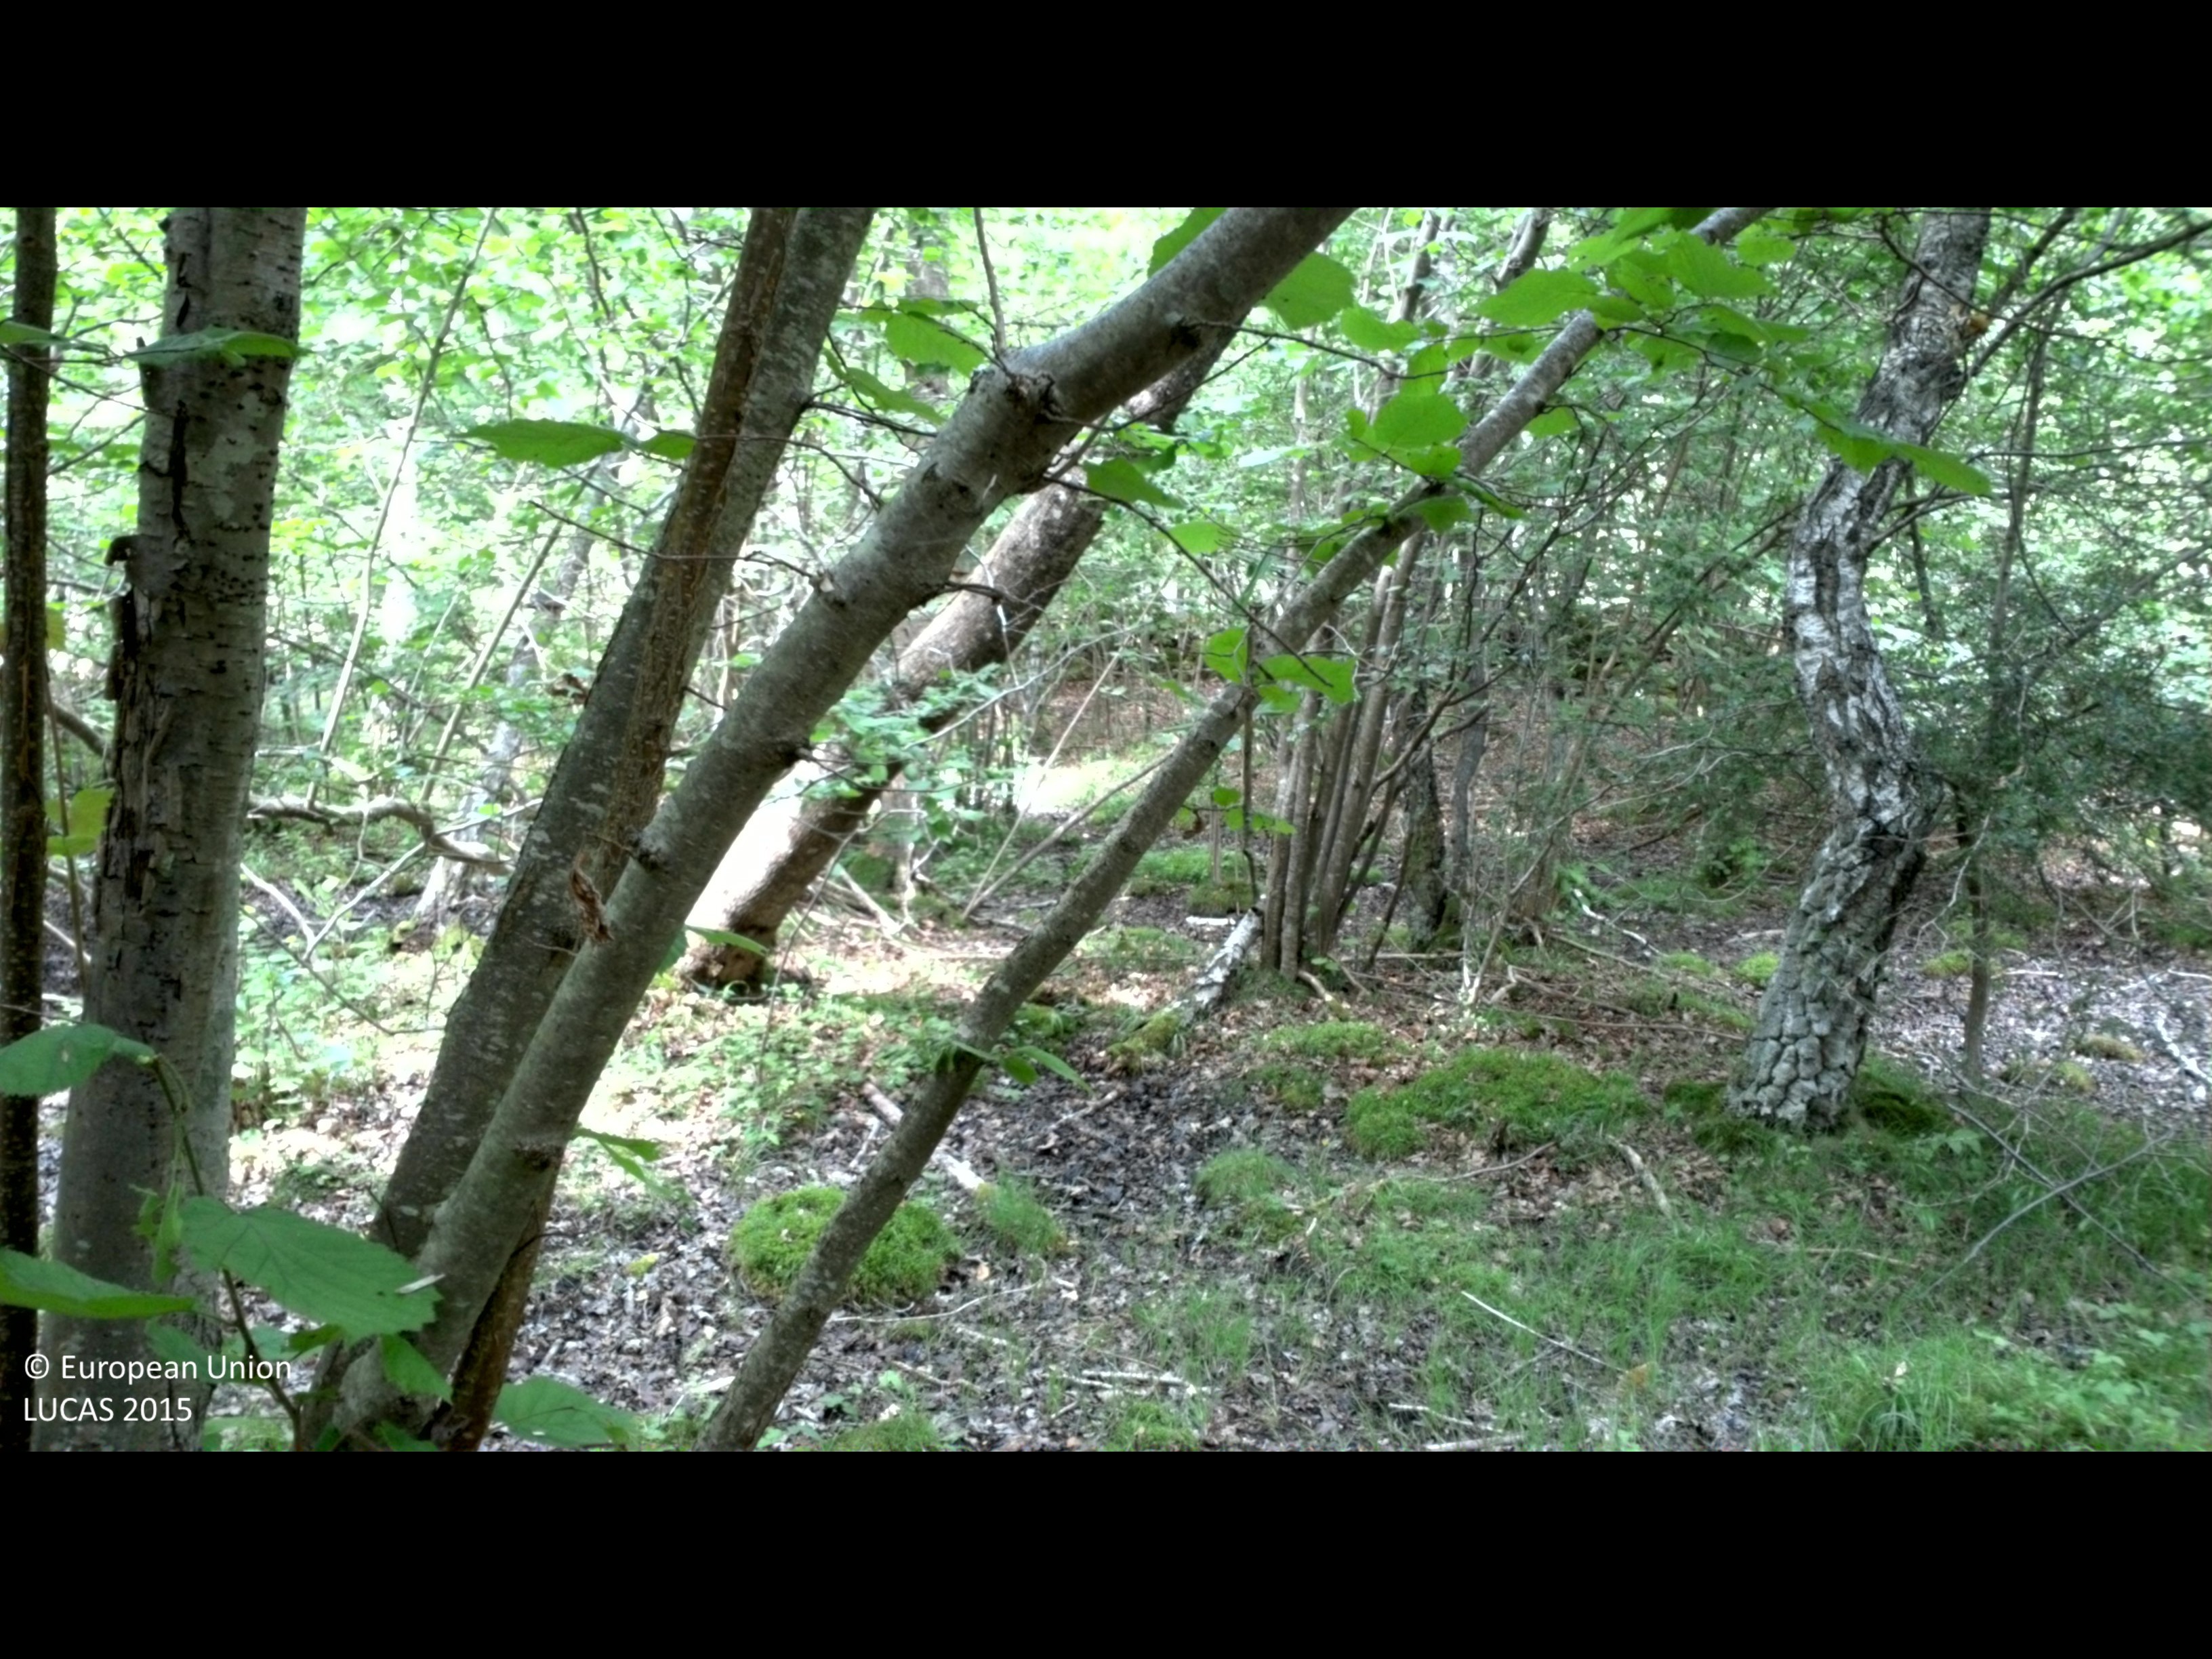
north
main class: Woodland
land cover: Broadleaved woodland
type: mesophytic deciduous forest
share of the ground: > 75 %
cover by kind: shrubs 55 %, broadleaved forest trees 40 %, herbaceous plants 5 %
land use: Forestry
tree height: > 5 m
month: July
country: SE
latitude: 56.7906
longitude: 16.6645
